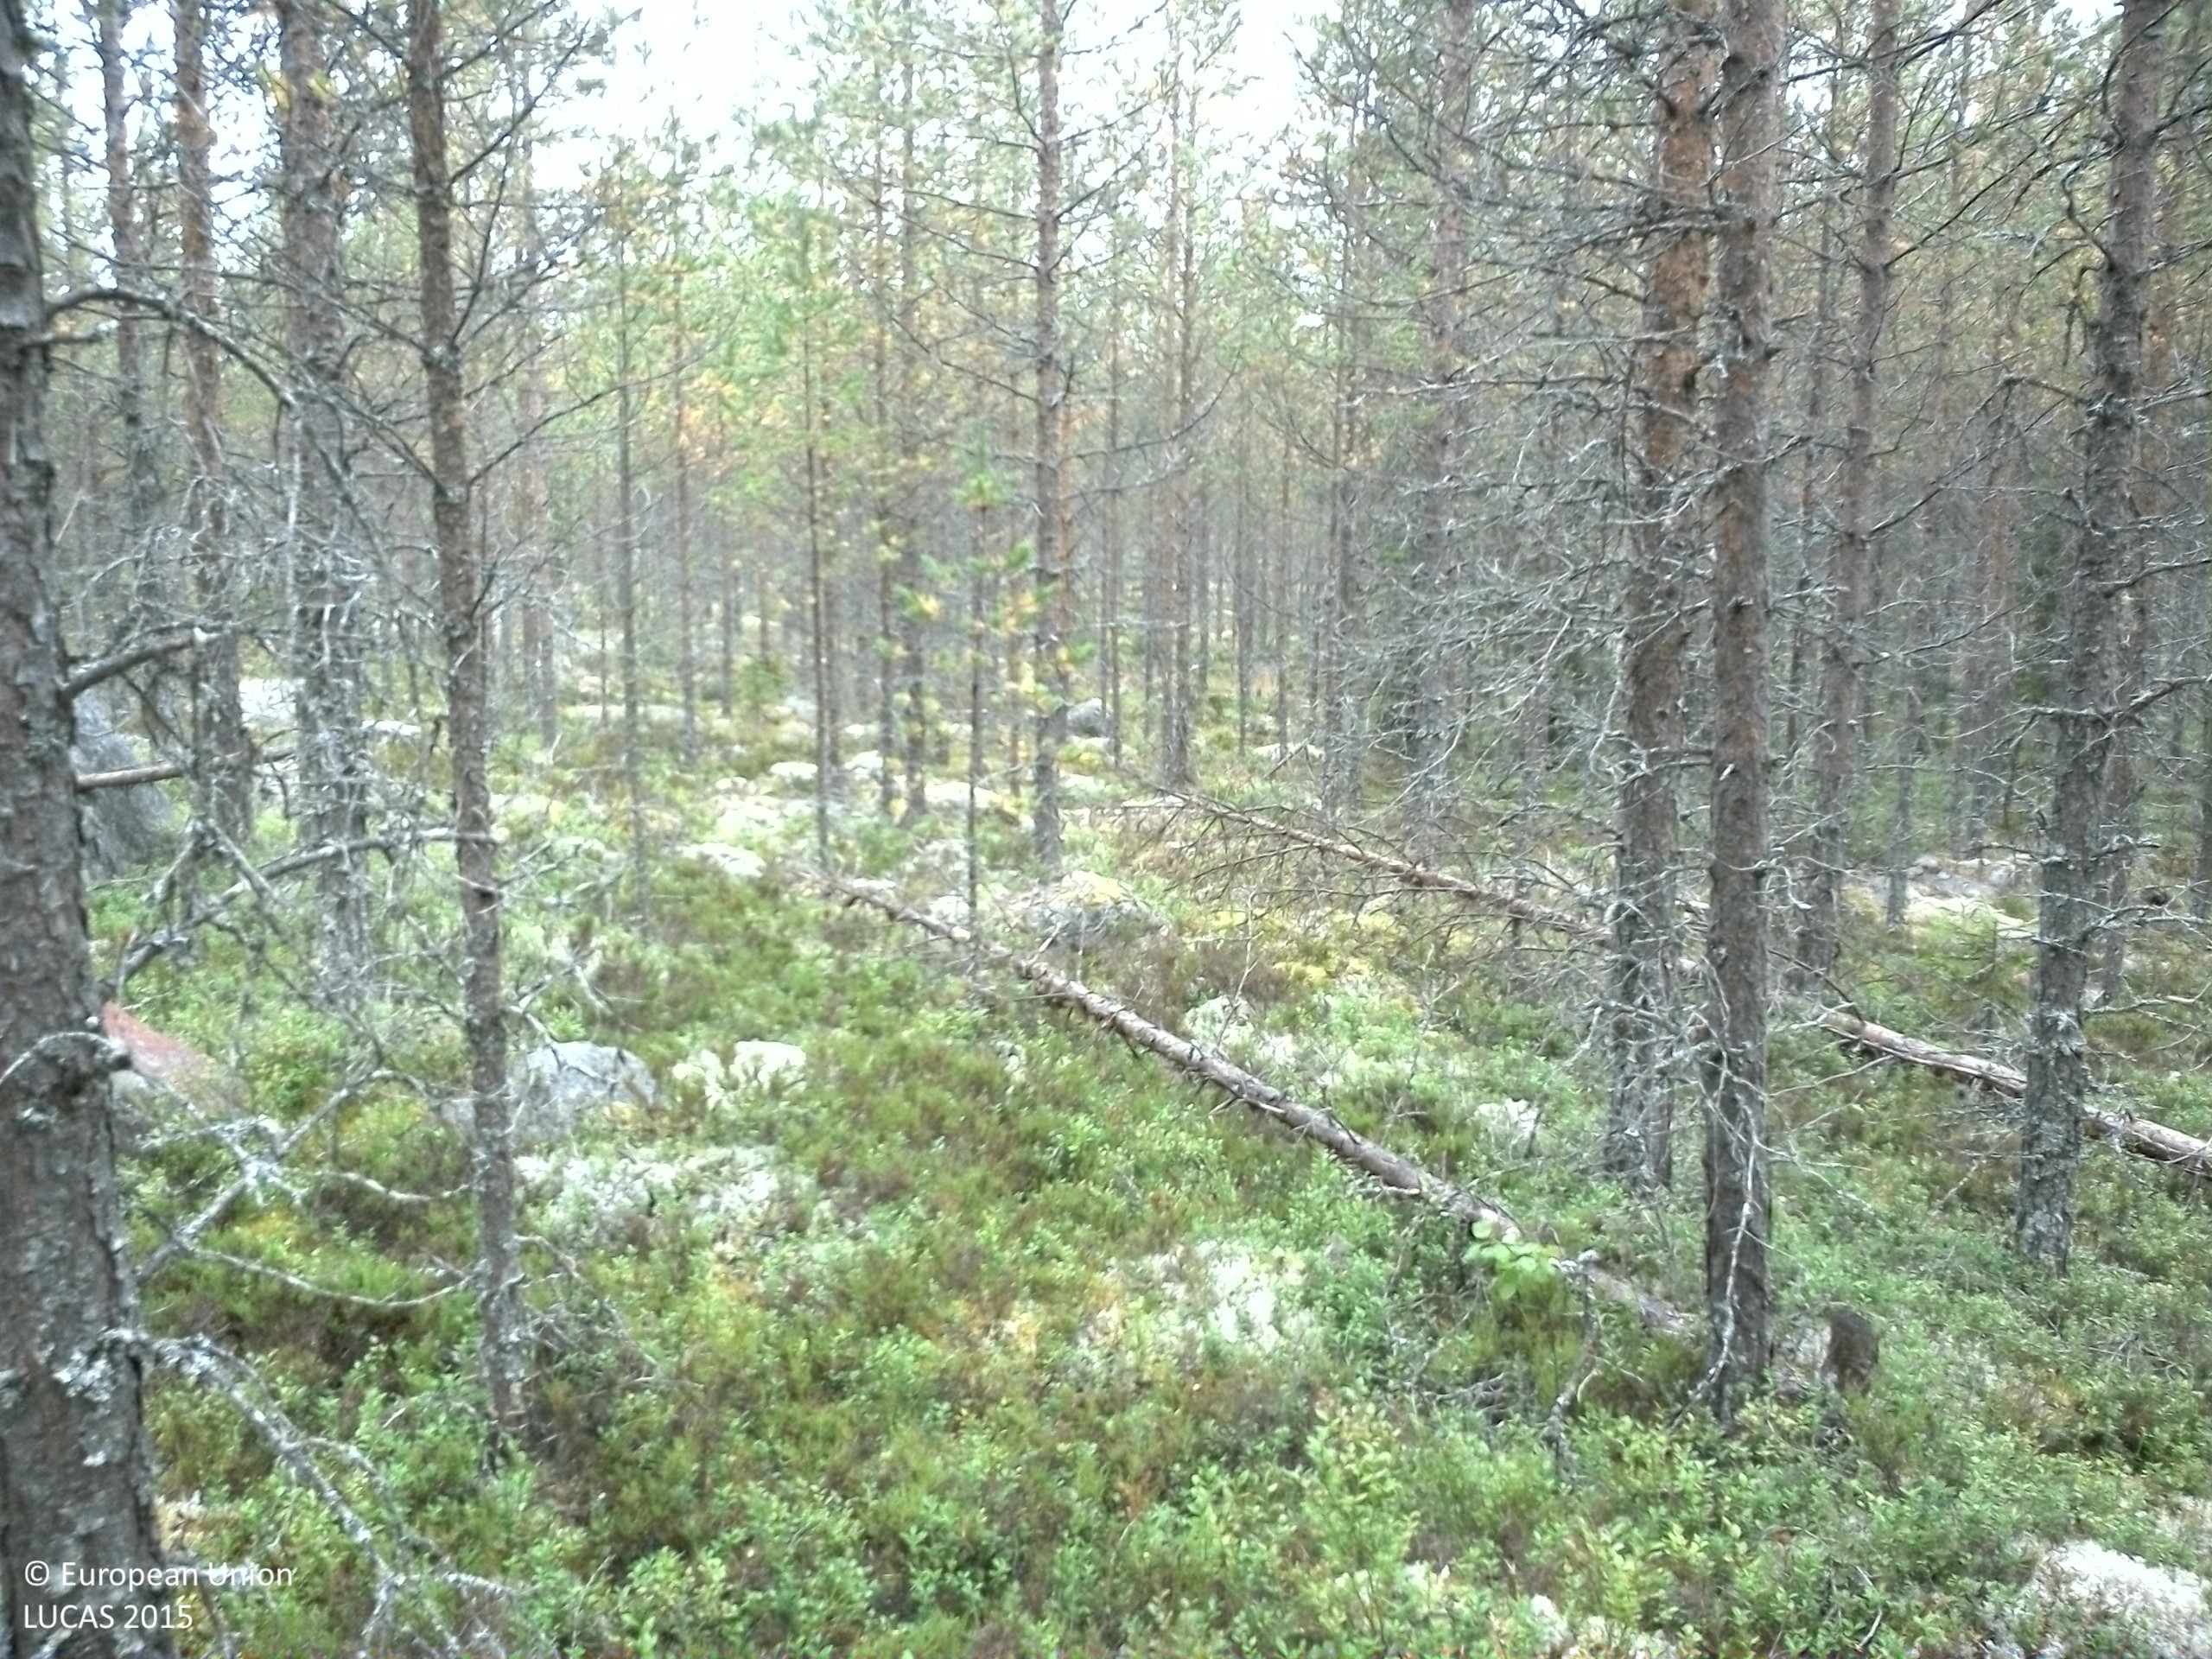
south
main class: Woodland
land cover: Pine dominated coniferous woodland
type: boreal forest
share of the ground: > 75 %
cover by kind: coniferous forest trees 75 %, shrubs 25 %
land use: Forestry
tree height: < 5 m
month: September
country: SE
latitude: 61.5318
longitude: 15.1181
